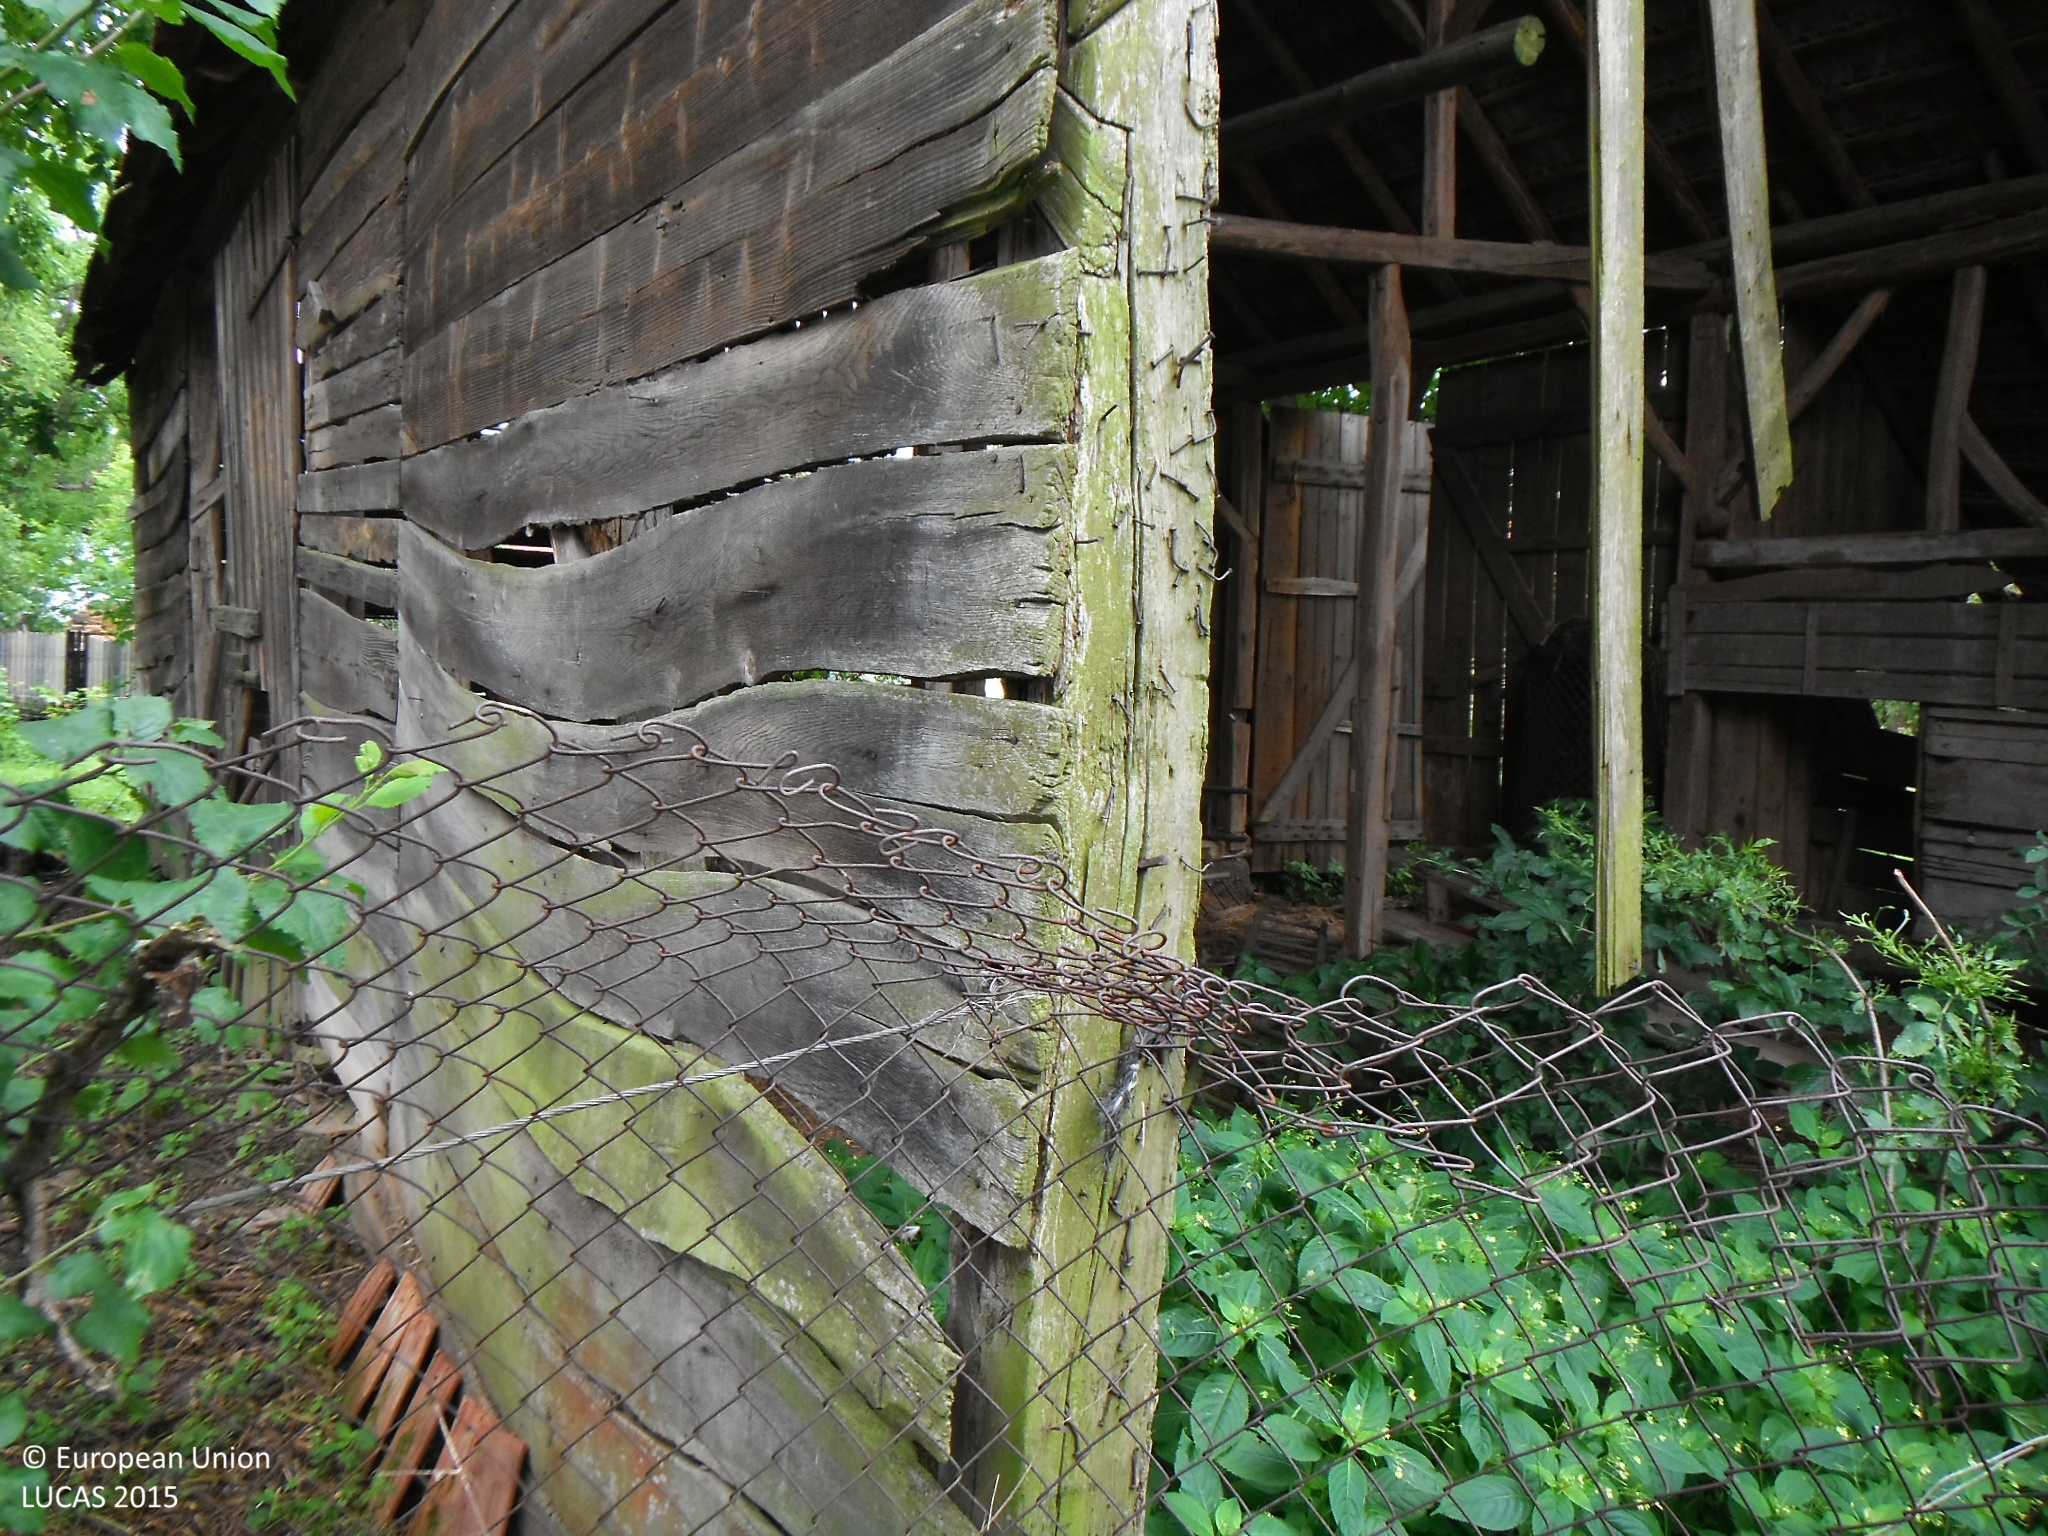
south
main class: Cropland
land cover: Nuts trees
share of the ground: 50 - 75 %
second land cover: Grassland without tree/shrub cover
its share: > 75 %
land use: Kitchen garden
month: July
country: SK
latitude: 48.7821
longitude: 21.3278
